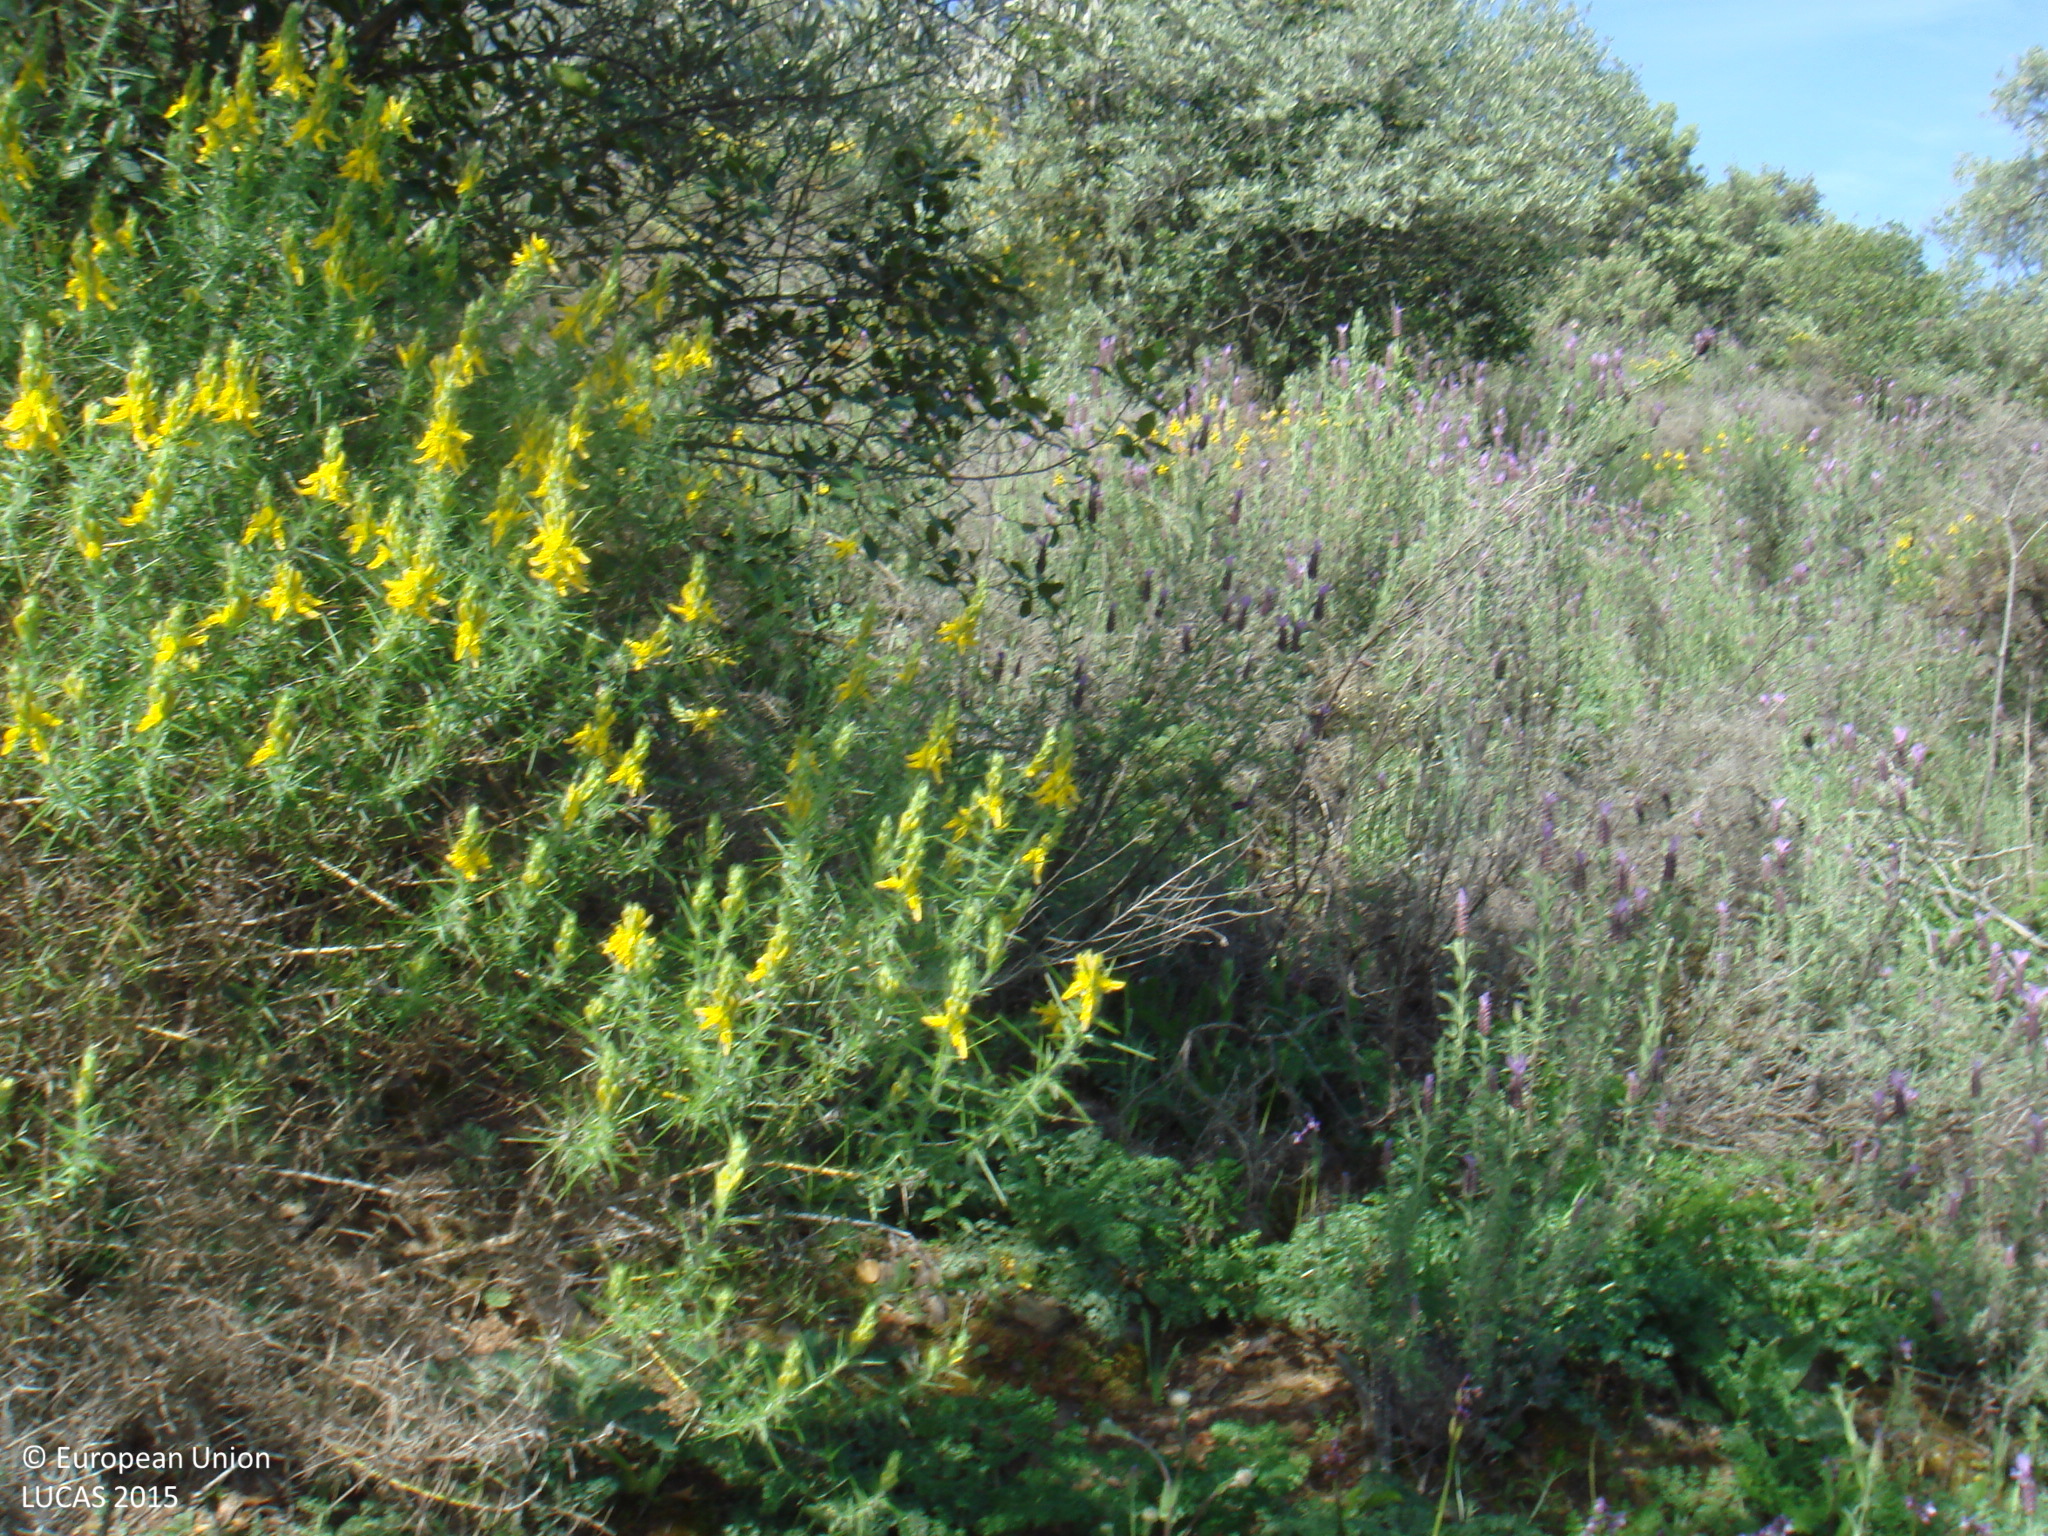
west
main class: Shrubland
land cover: Shrubland with sparse tree cover
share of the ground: > 75 %
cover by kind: shrubs 65 %, herbaceous plants 30 %, broadleaved forest trees 5 %
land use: Agriculture (excluding fallow land and kitchen gardens)
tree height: < 5 m
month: April
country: ES
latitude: 38.0642
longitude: -4.6159
